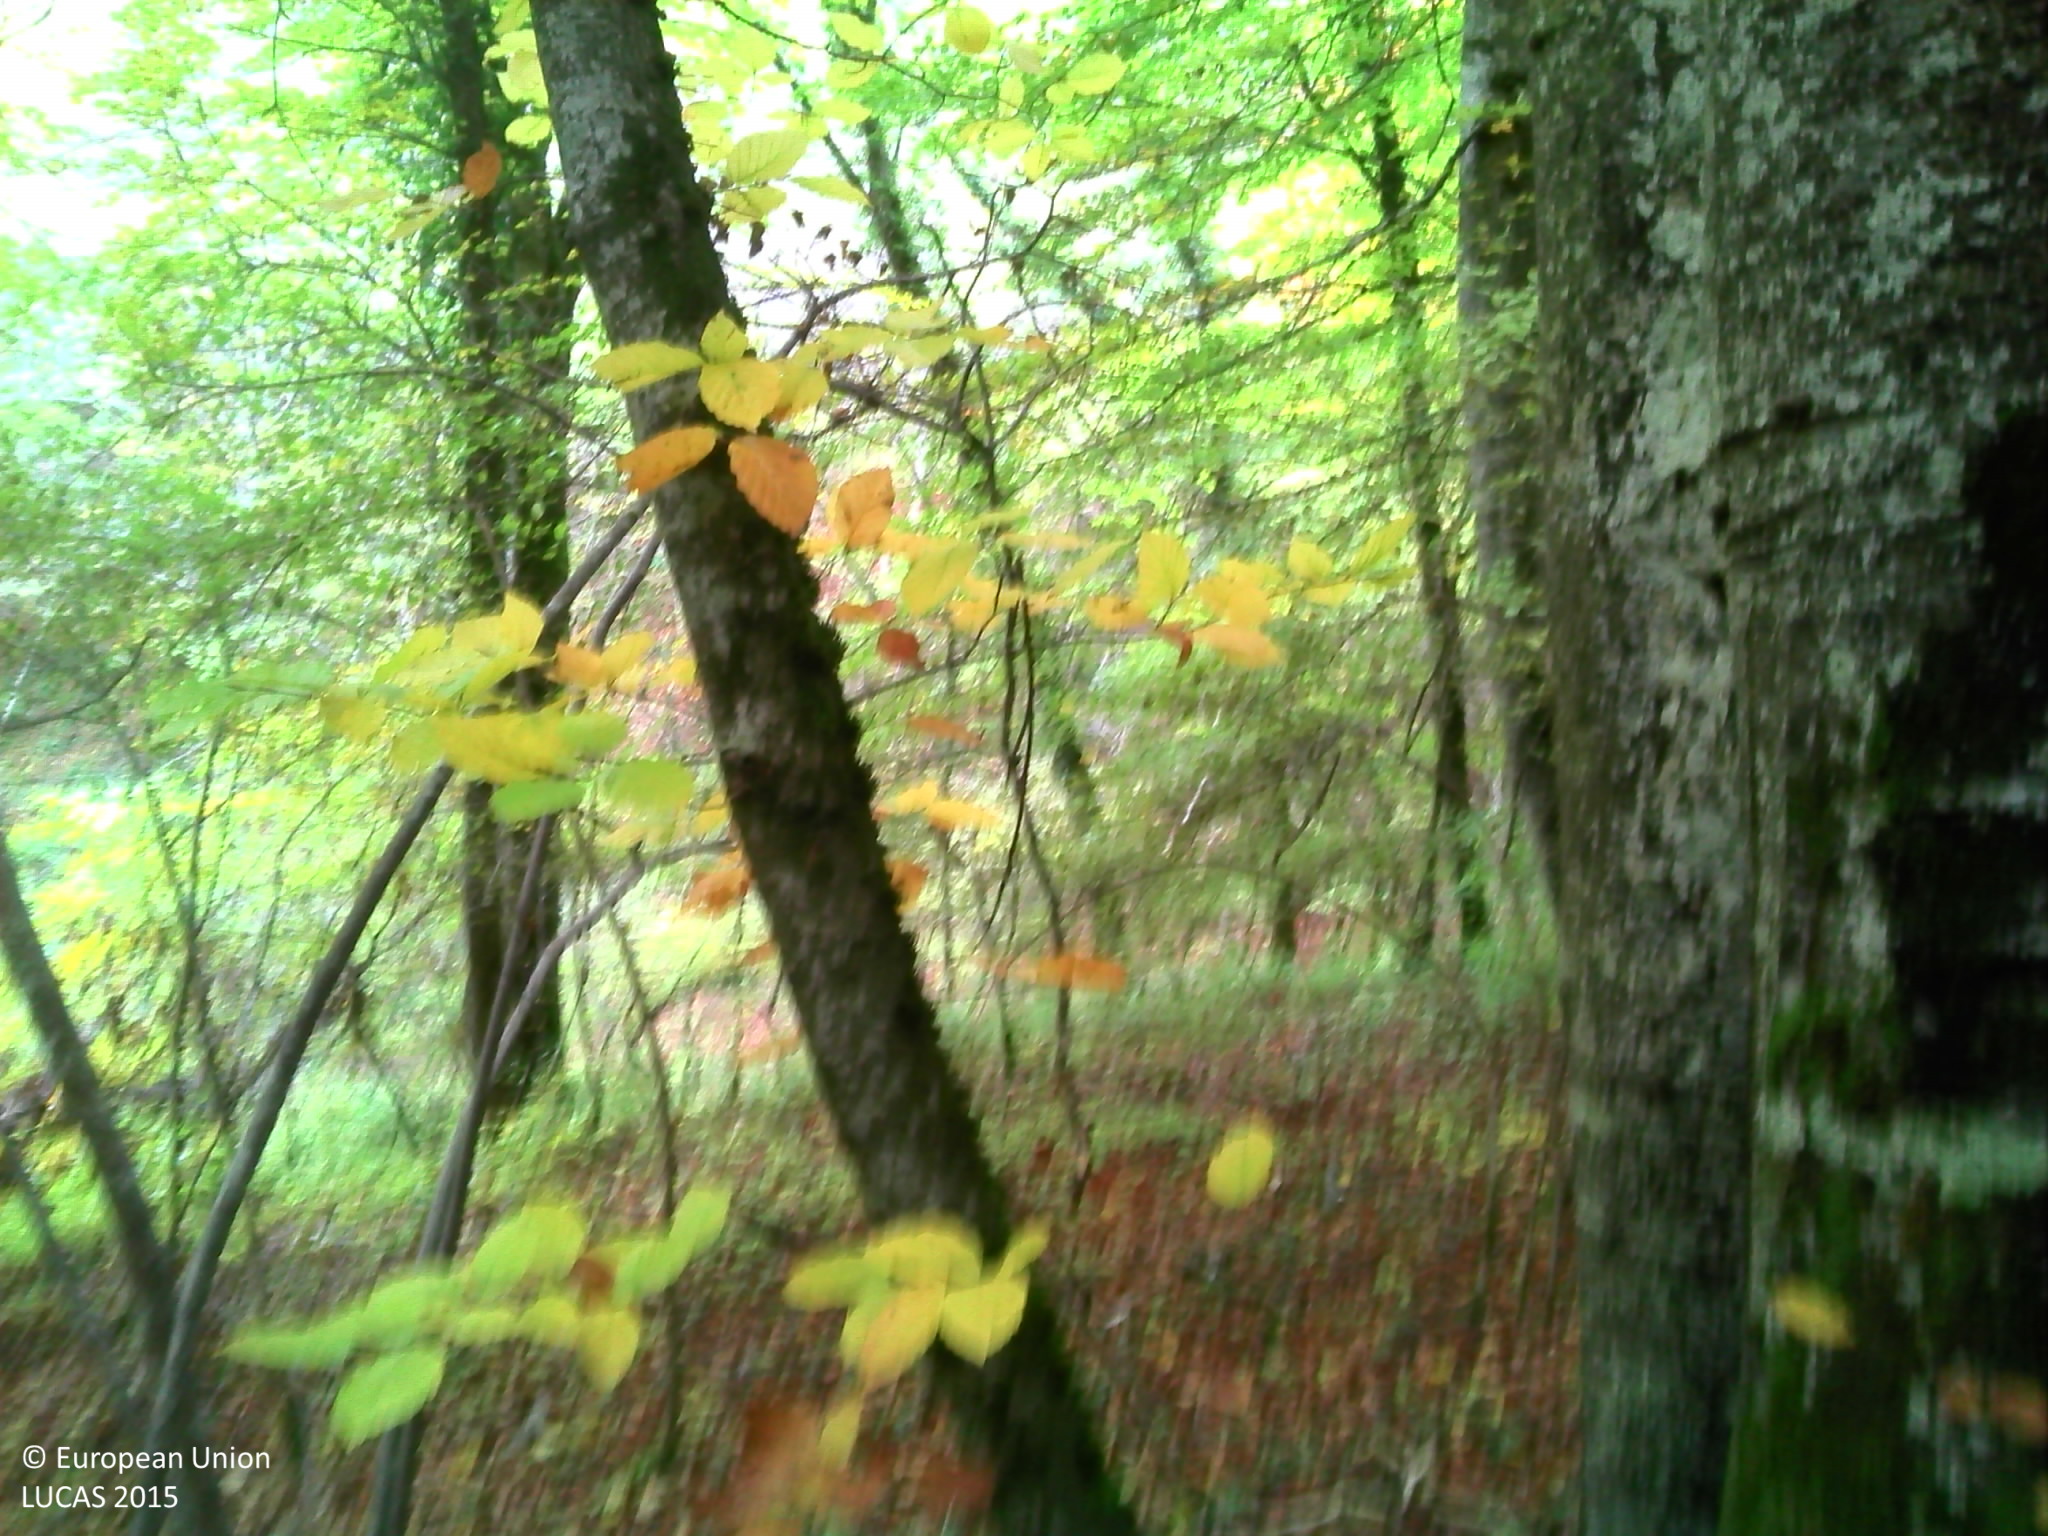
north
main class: Woodland
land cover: Broadleaved woodland
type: beech forest
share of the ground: > 75 %
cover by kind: broadleaved forest trees 100 %
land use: Forestry
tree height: > 5 m
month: October
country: FR
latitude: 47.4238
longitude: 4.9761
